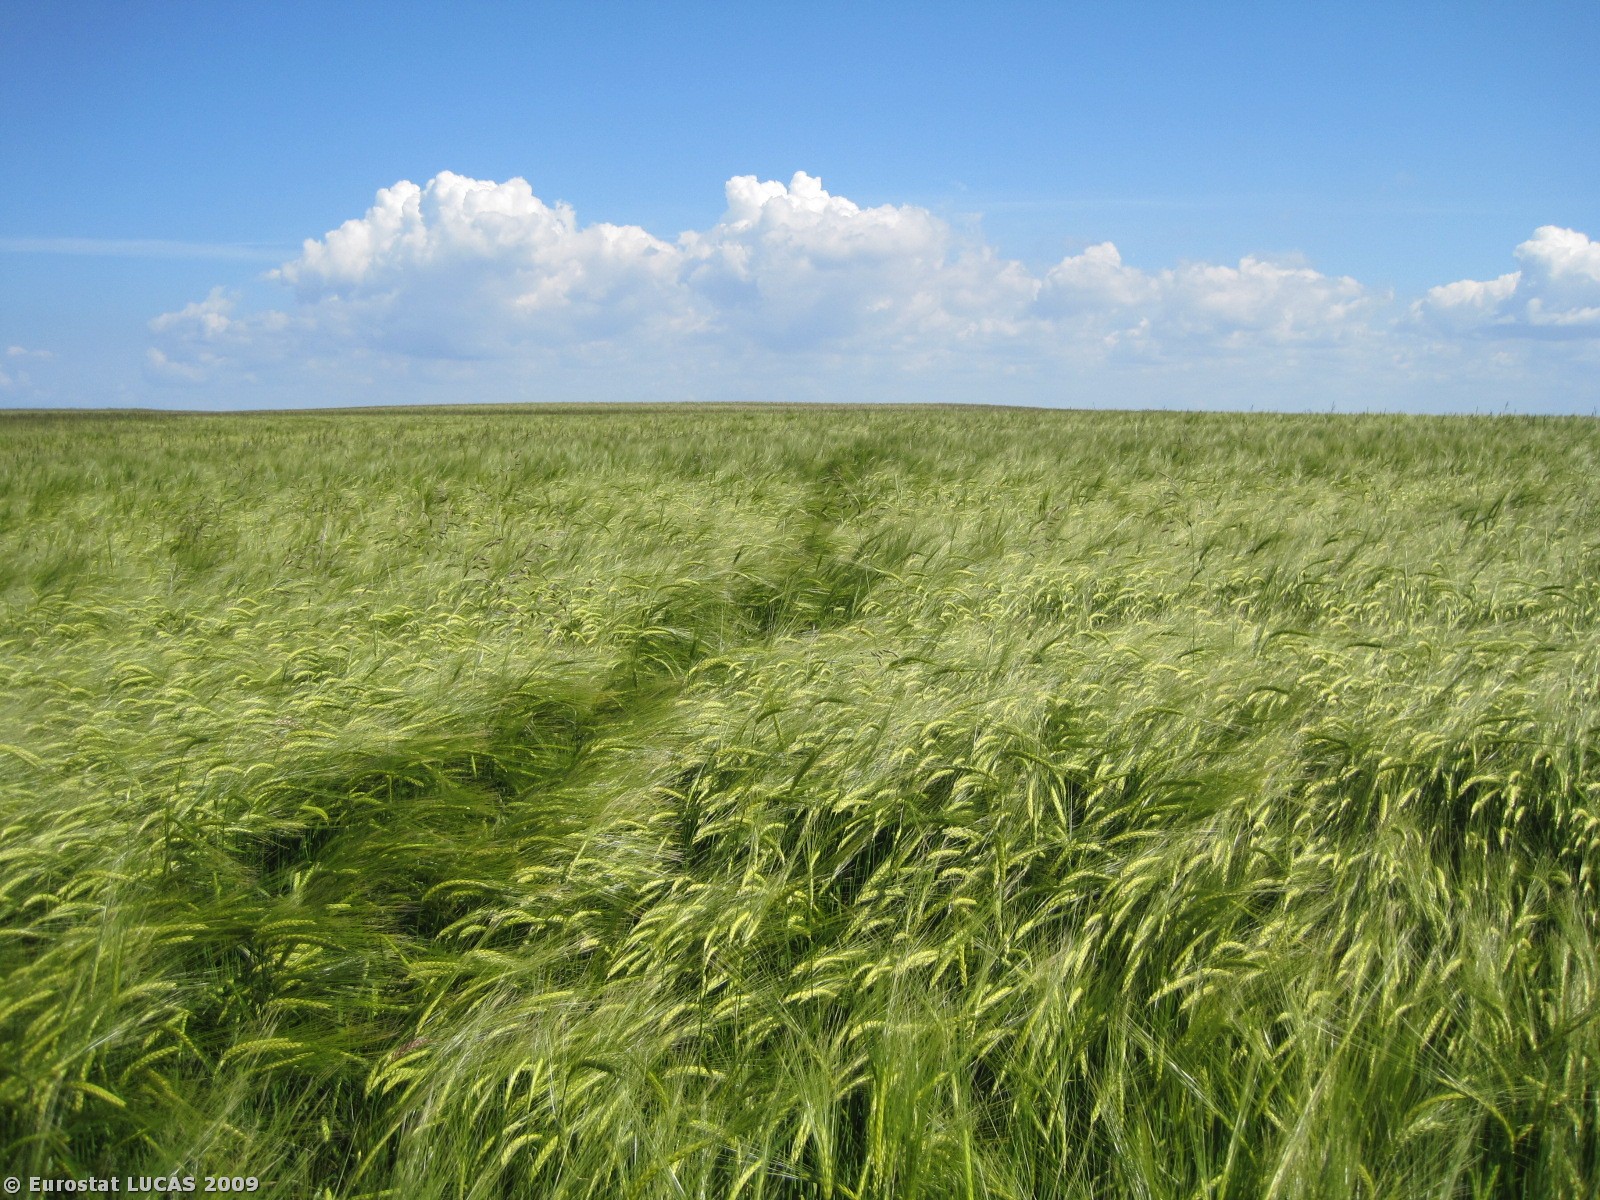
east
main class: Cropland
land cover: Barley
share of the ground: > 75 %
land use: Agriculture (excluding fallow land and kitchen gardens)
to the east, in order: Barley
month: June
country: DK
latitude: 56.9022
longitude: 8.9015
